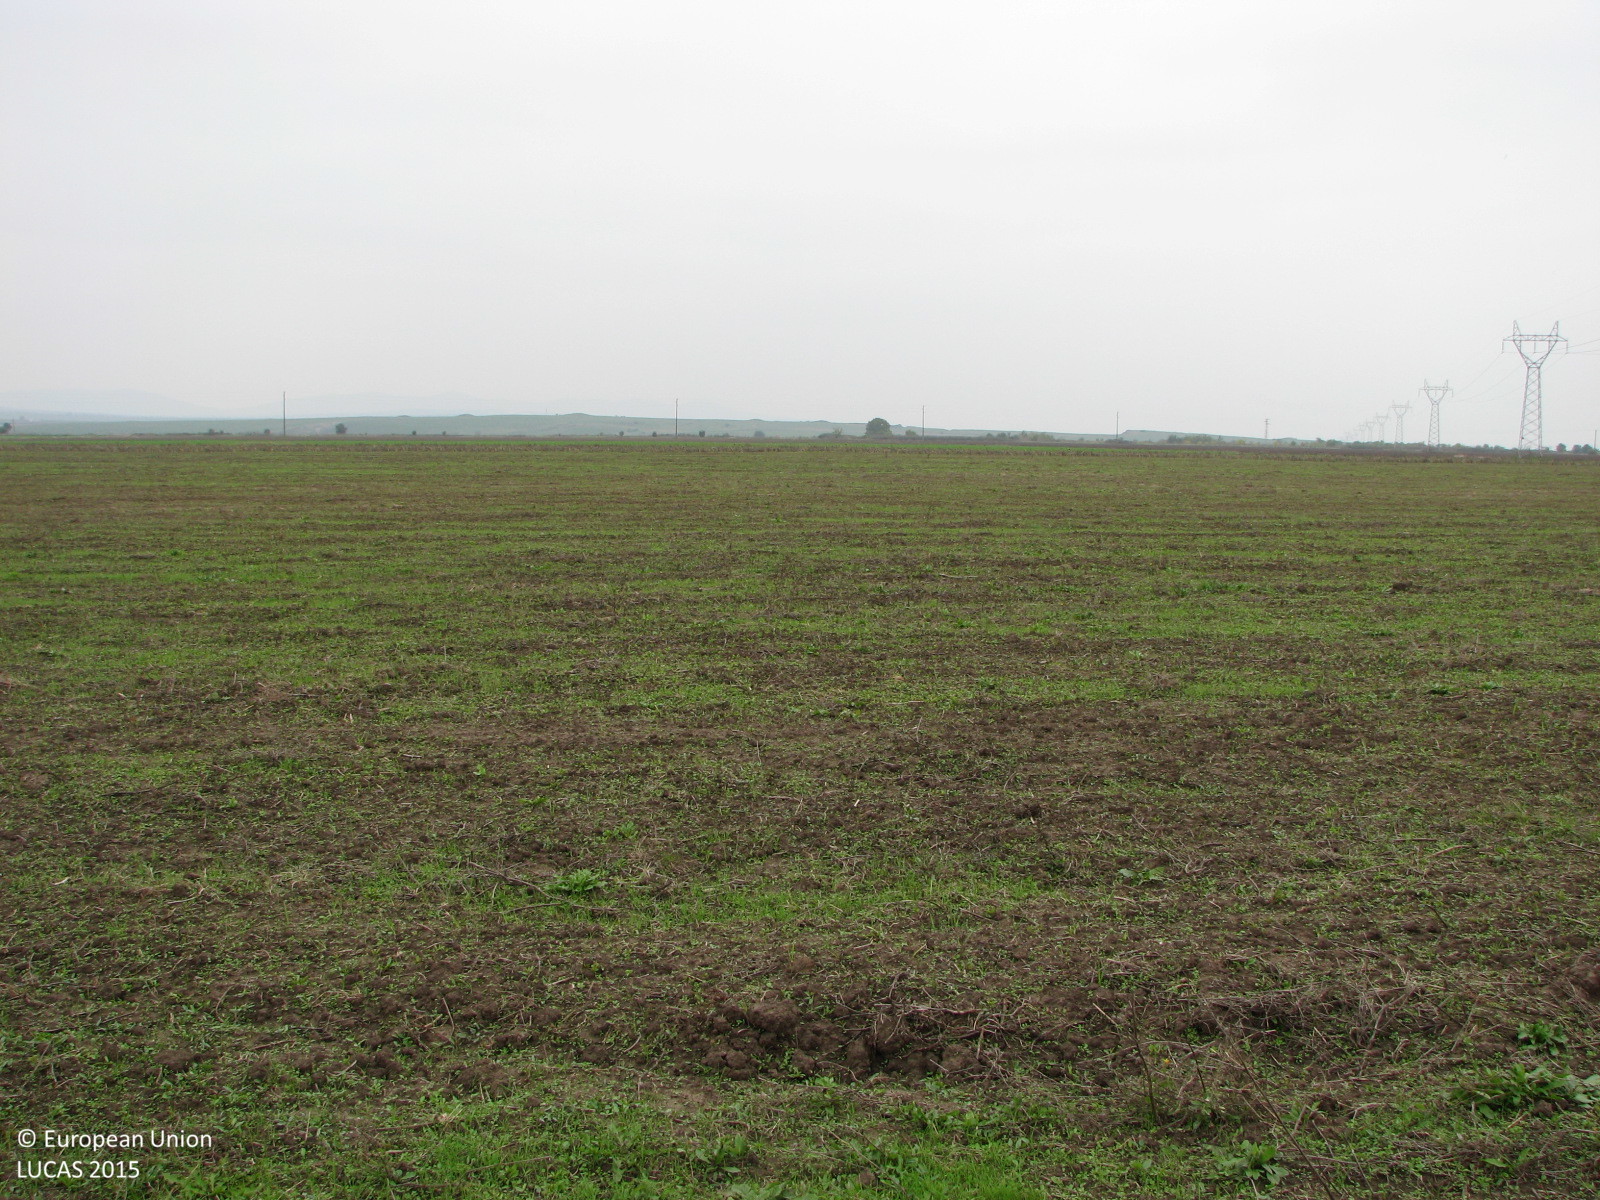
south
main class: Grassland
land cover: Spontaneously vegetated surfaces
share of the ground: 25 - 50 %
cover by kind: herbaceous plants 100 %
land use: Agriculture (excluding fallow land and kitchen gardens)
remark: Harvested field
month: October
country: BG
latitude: 42.5680
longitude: 26.7767
